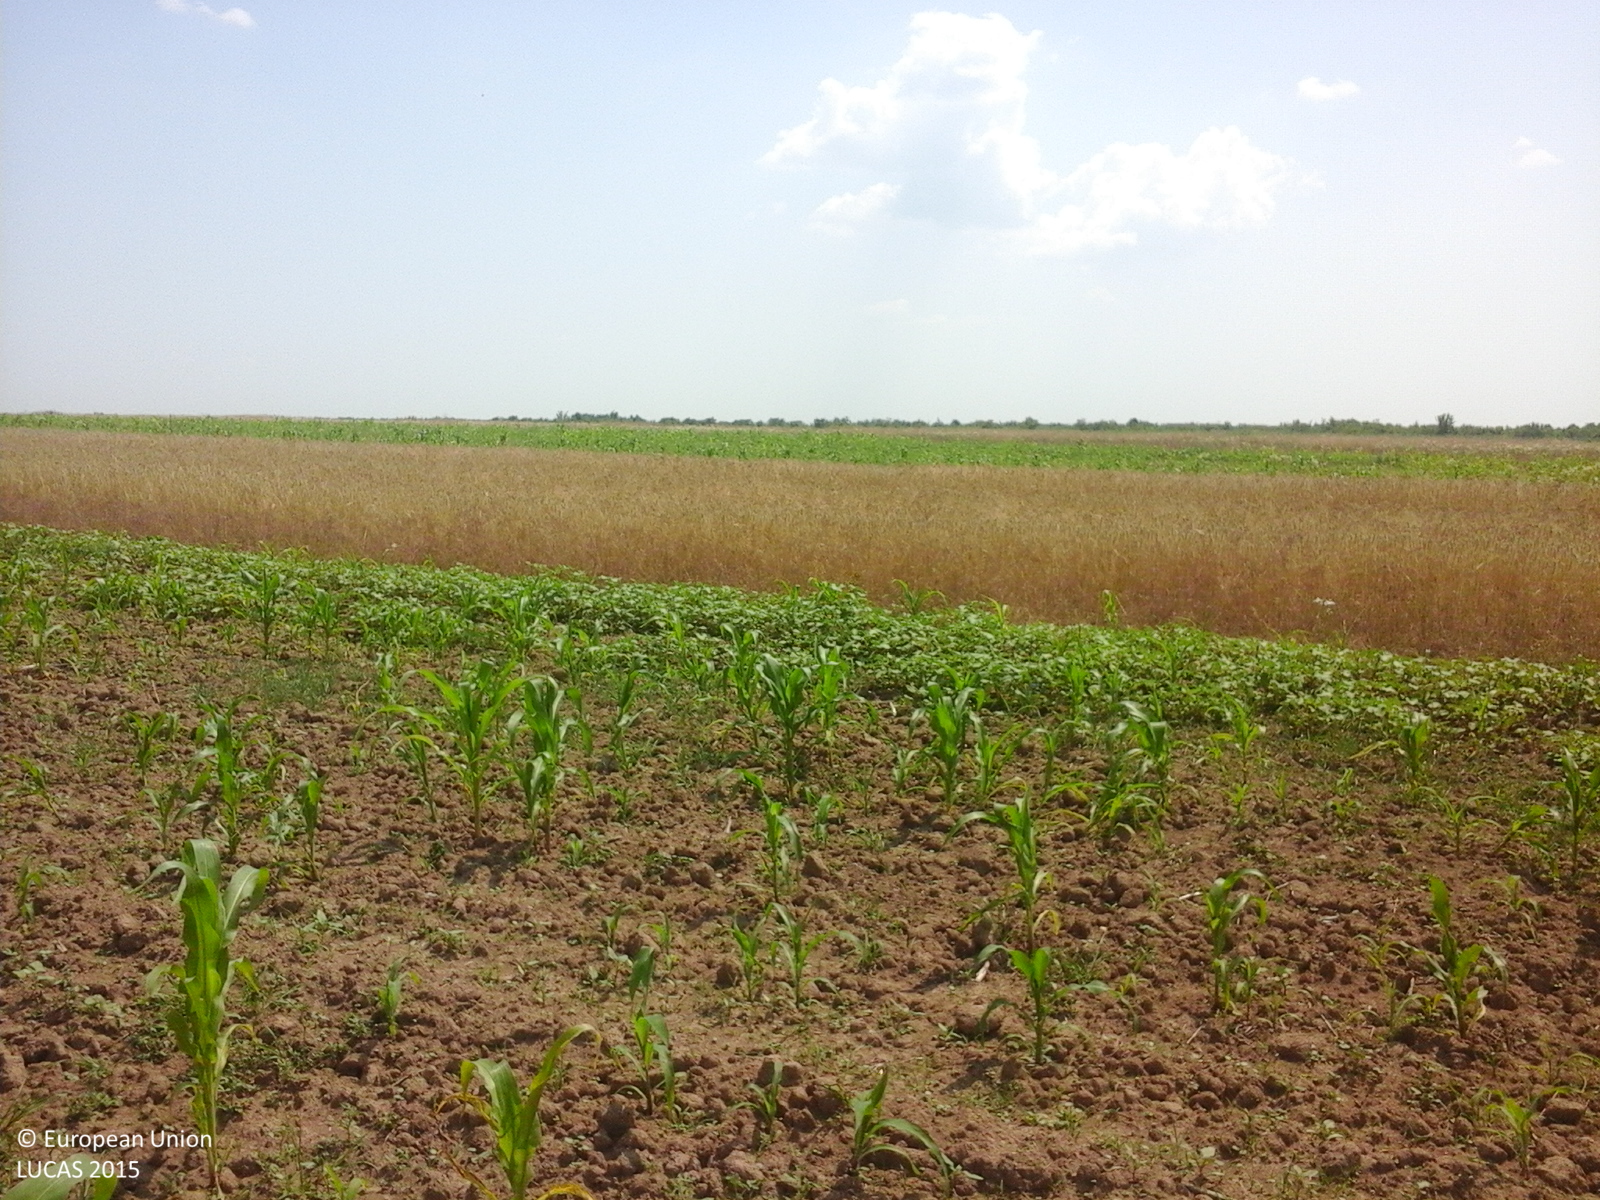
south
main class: Cropland
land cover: Maize
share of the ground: < 10 %
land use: Agriculture (excluding fallow land and kitchen gardens)
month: July
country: RO
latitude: 44.7761
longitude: 24.4661
